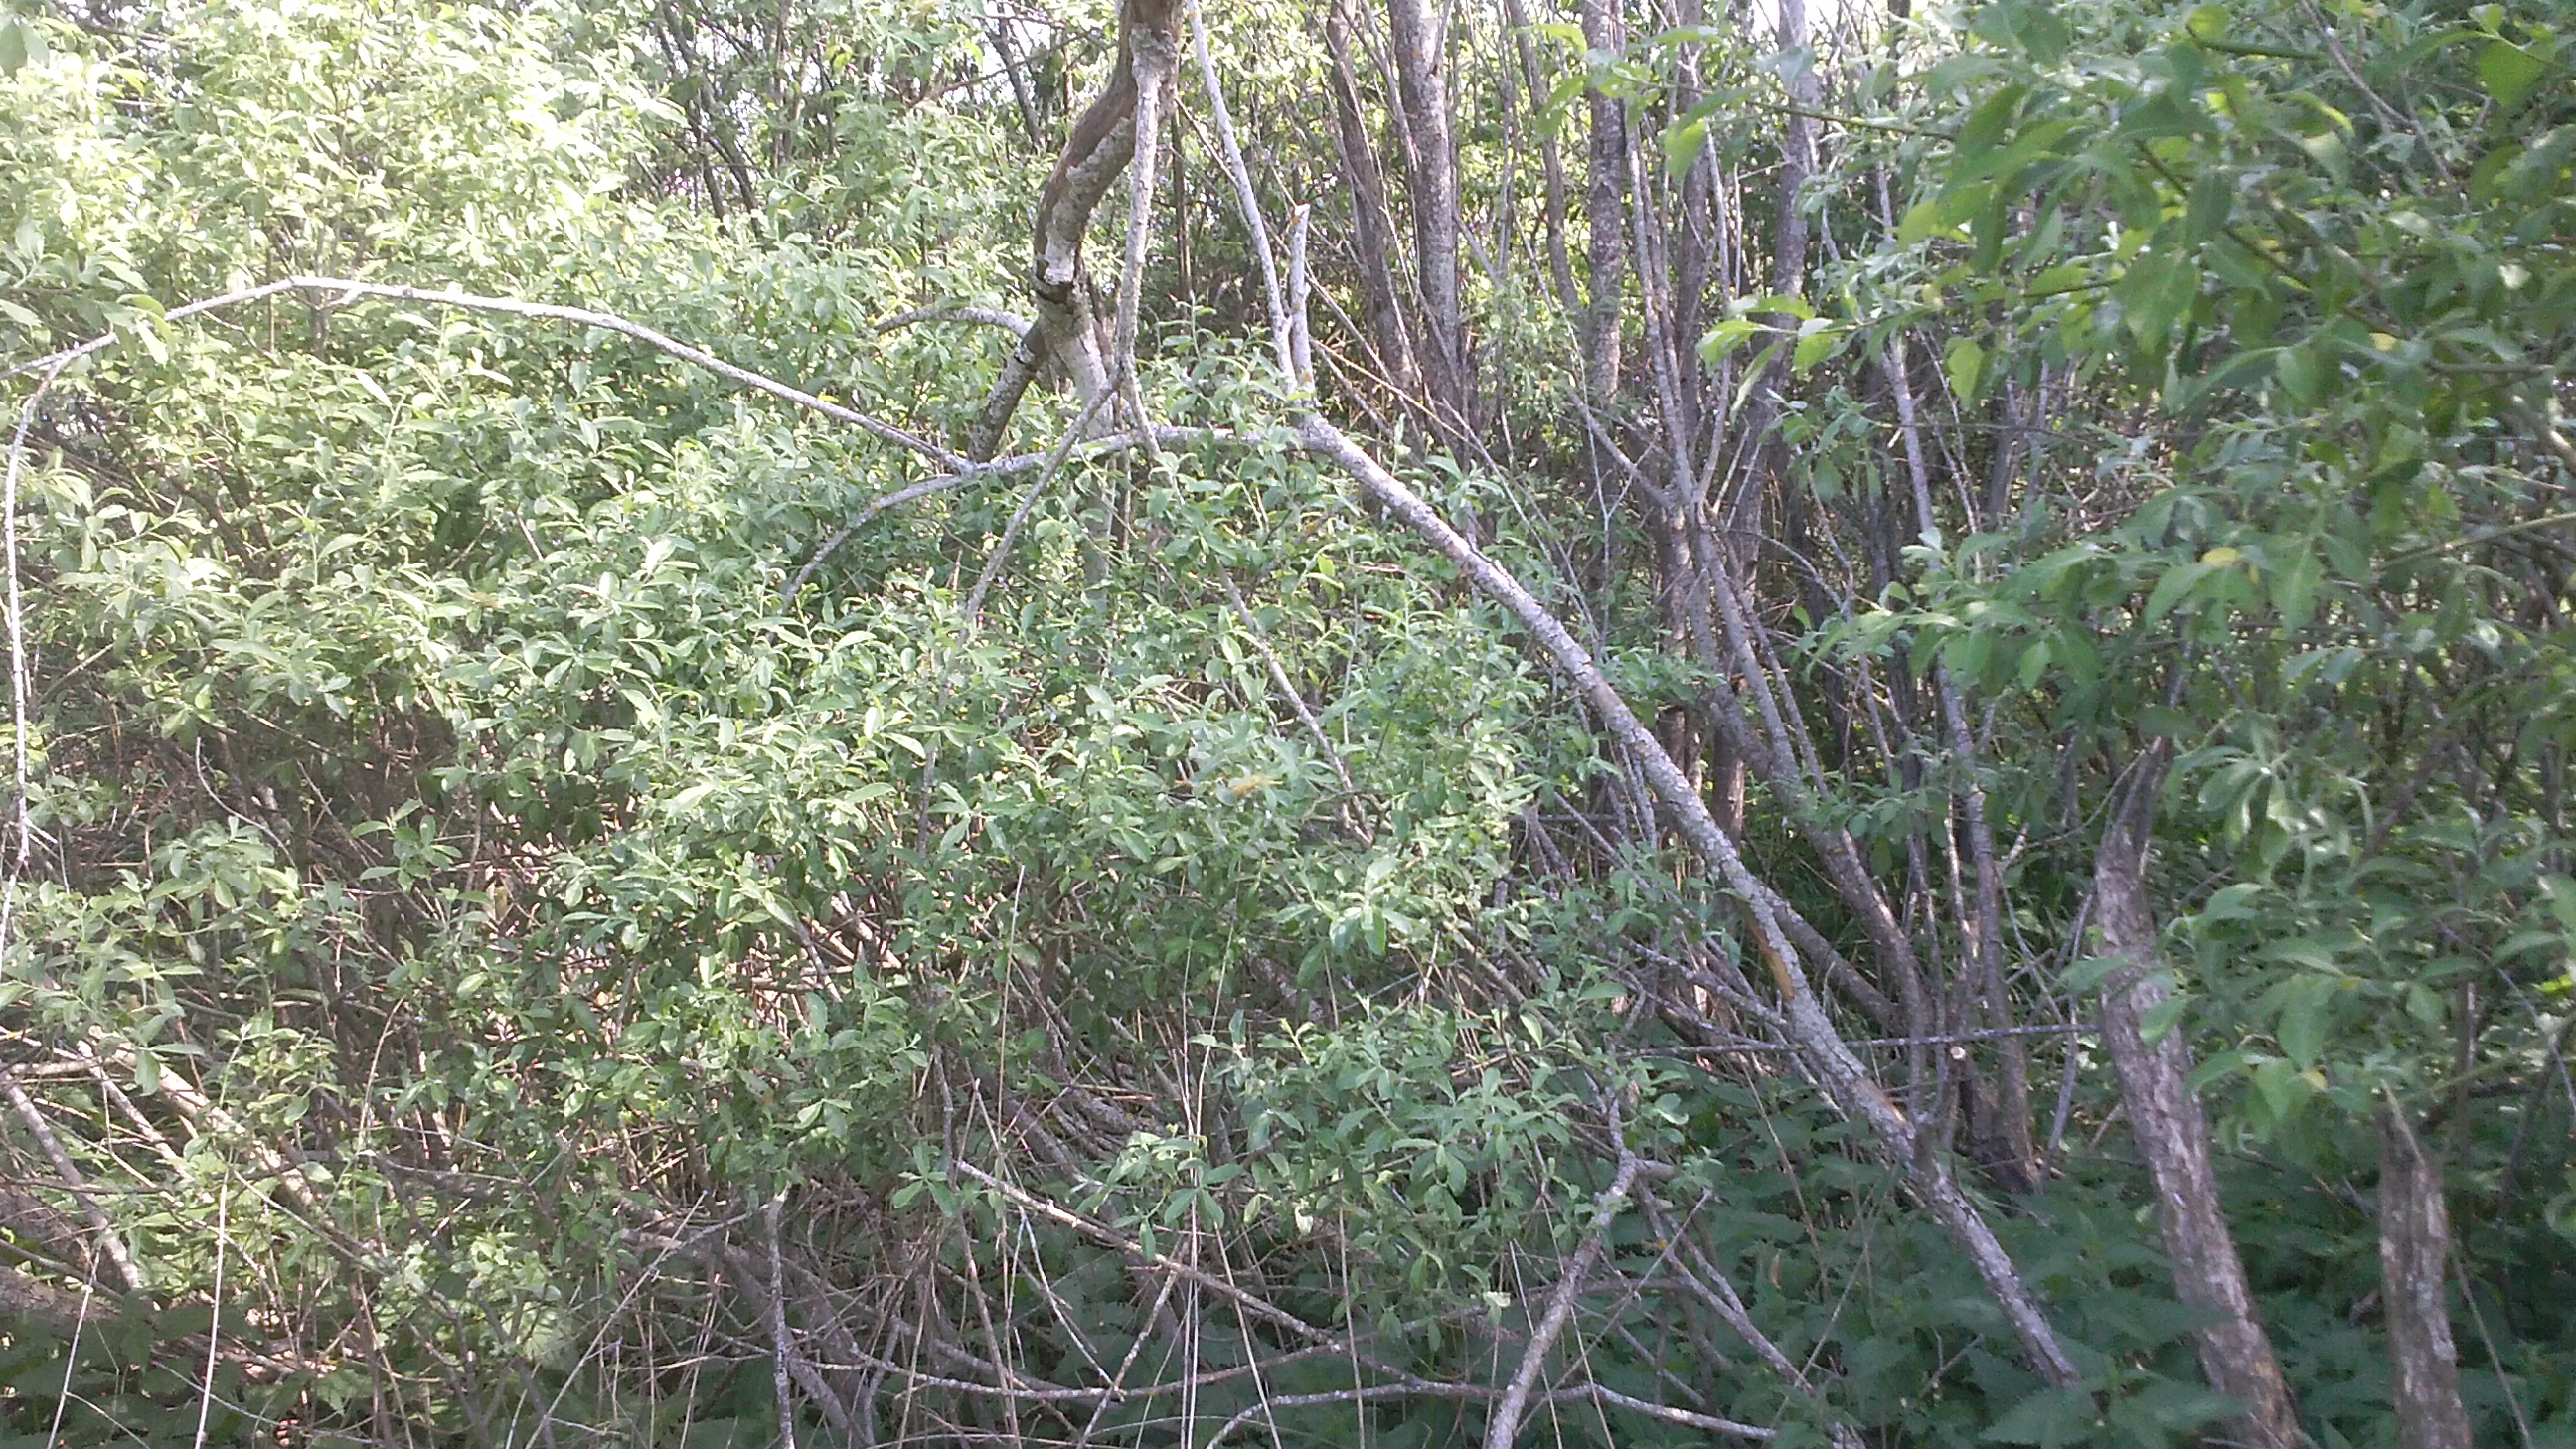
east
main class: Shrubland
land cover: Shrubland without tree cover
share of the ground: > 75 %
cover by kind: shrubs 90 %, herbaceous plants 10 %
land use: Semi-natural and natural areas not in use
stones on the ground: < 10 %
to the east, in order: Shrubland without tree cover; Spontaneously vegetated surfaces; Broadleaved woodland; Electric lines; Grassland with sparse tree/shrub cover; Grassland without tree/shrub cover; Tracks; Grassland without tree/shrub cover; Paved roads, cycling and walking lanes; Grassland without tree/shrub cover
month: June
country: LV
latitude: 56.2345
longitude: 28.0922
